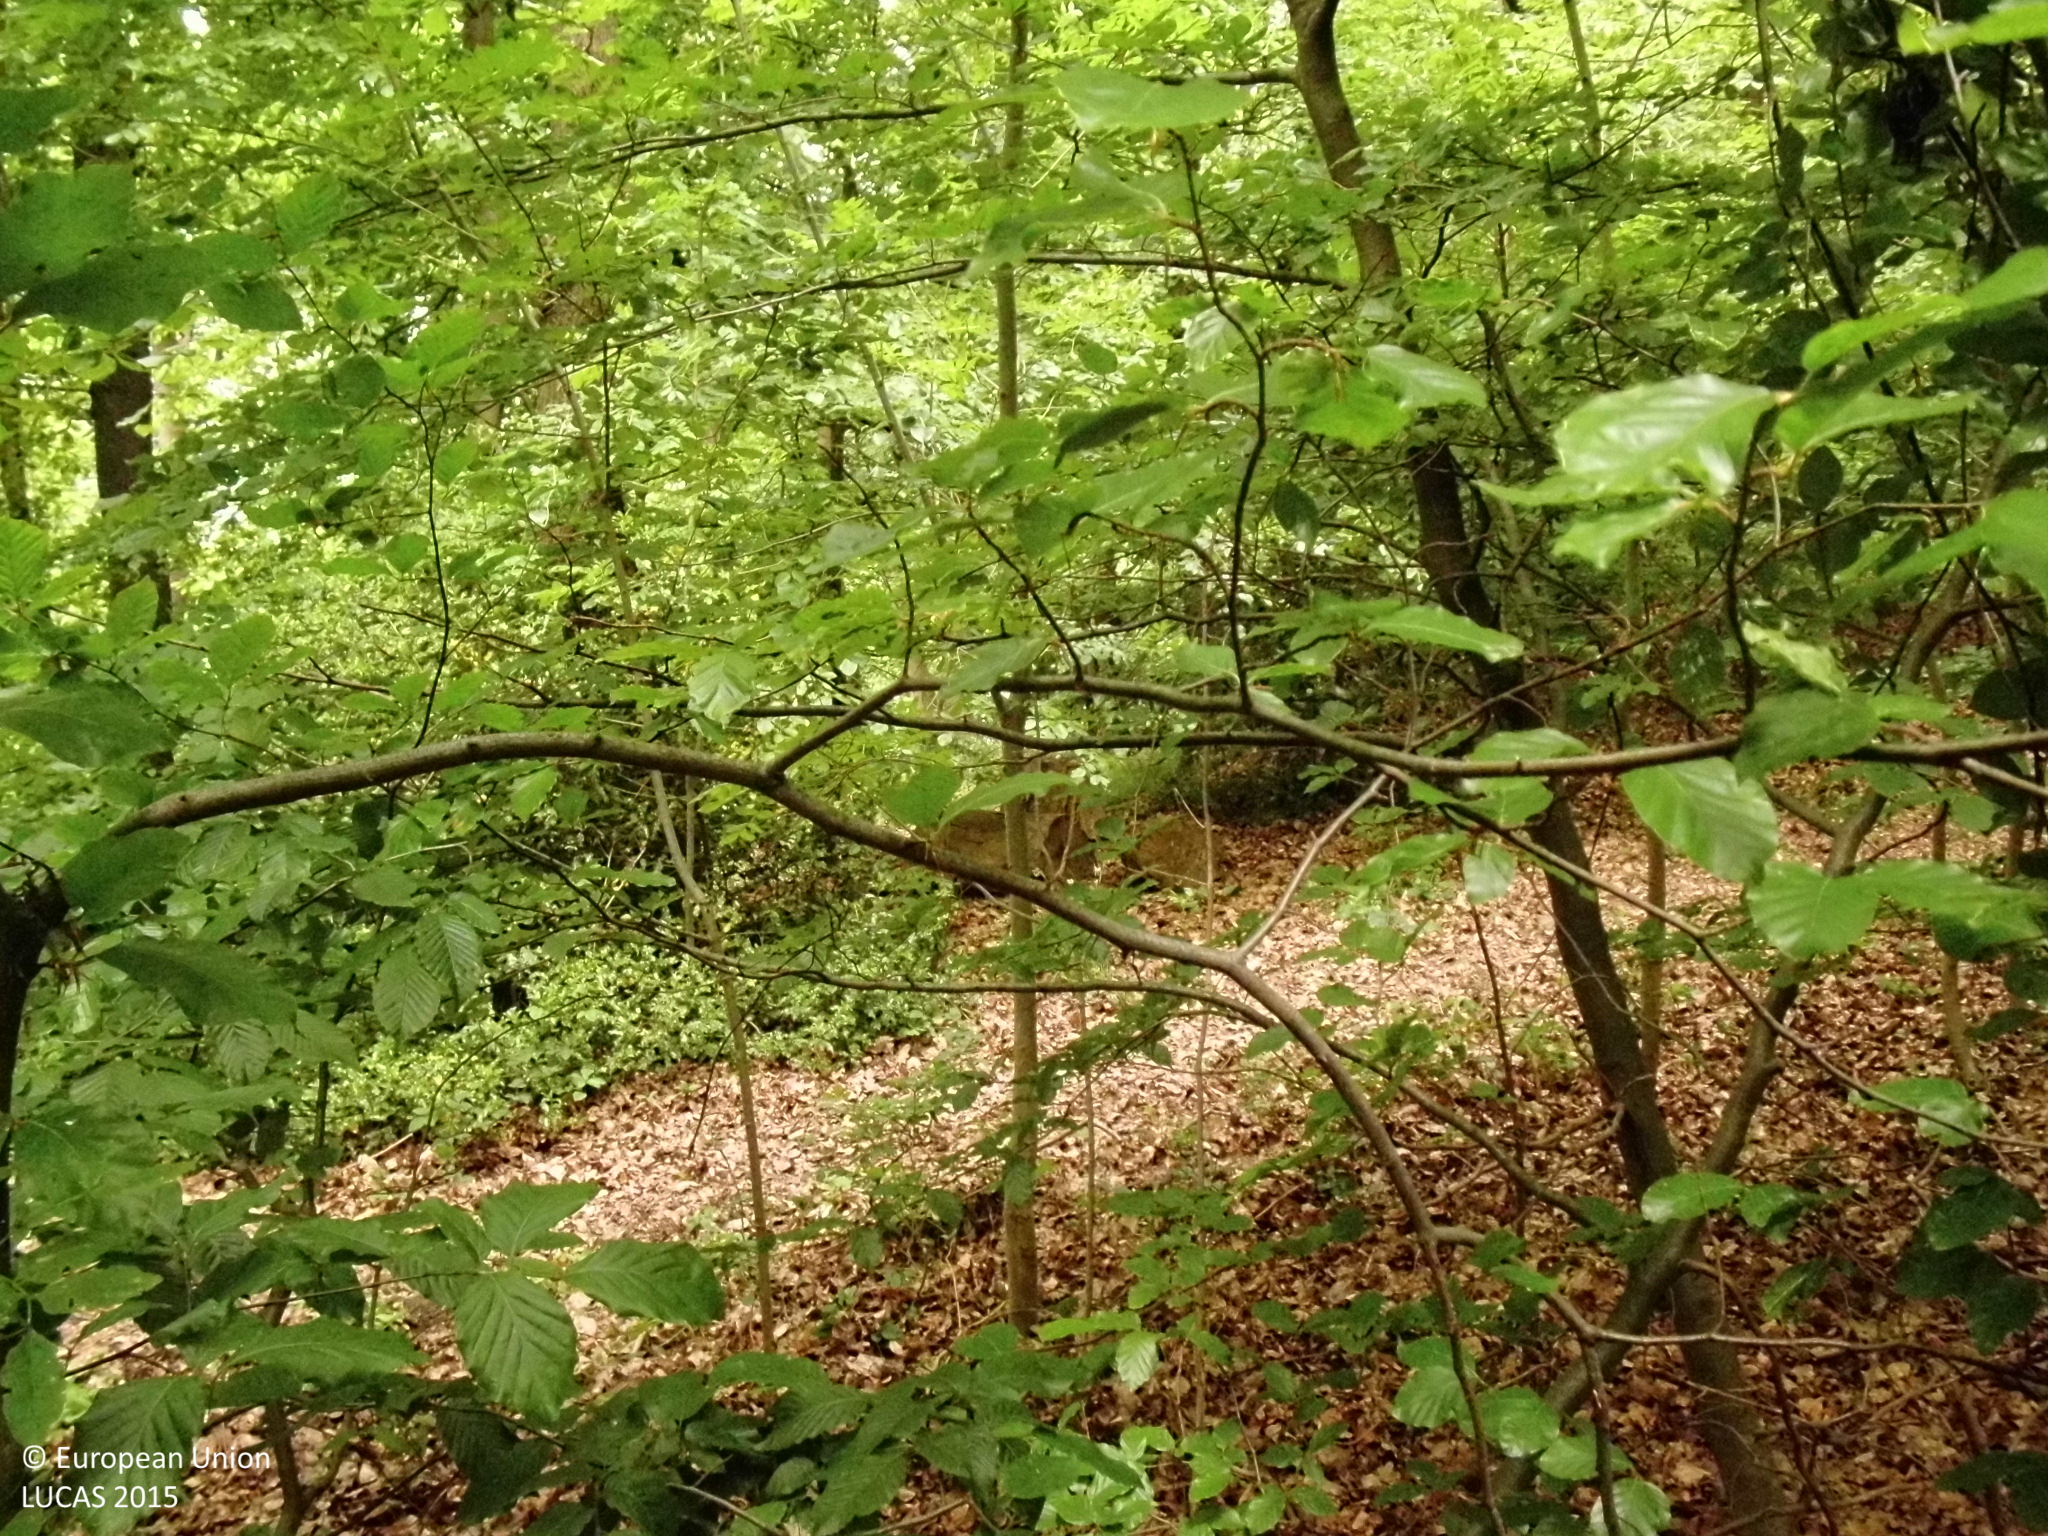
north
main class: Woodland
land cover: Broadleaved woodland
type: mesophytic deciduous forest
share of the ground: > 75 %
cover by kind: broadleaved forest trees 95 %, unconsolidated bare surface 5 %
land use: Forestry
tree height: > 5 m
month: May
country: DE
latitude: 51.3426
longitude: 7.4305
